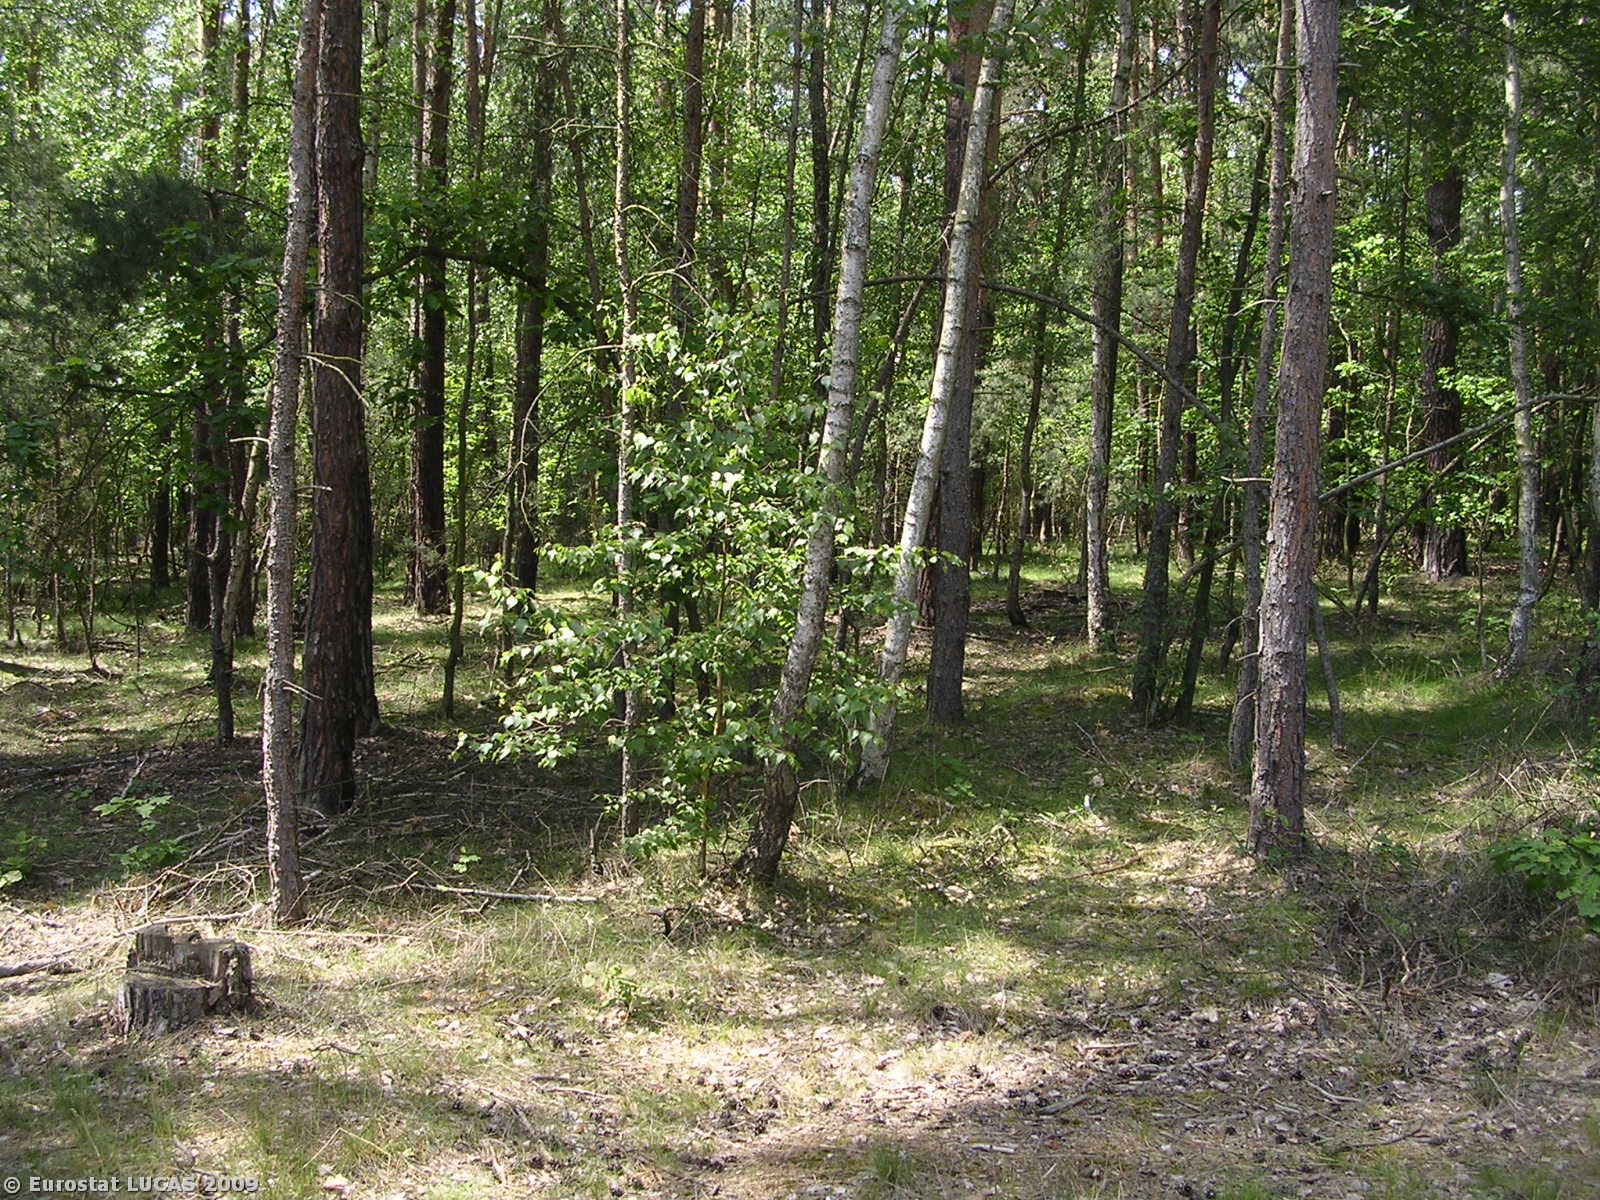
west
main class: Grassland
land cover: Grassland with sparse tree/shrub cover
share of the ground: > 75 %
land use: Forestry
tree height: > 5 m
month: May
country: CZ
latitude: 50.2315
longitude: 14.6984
